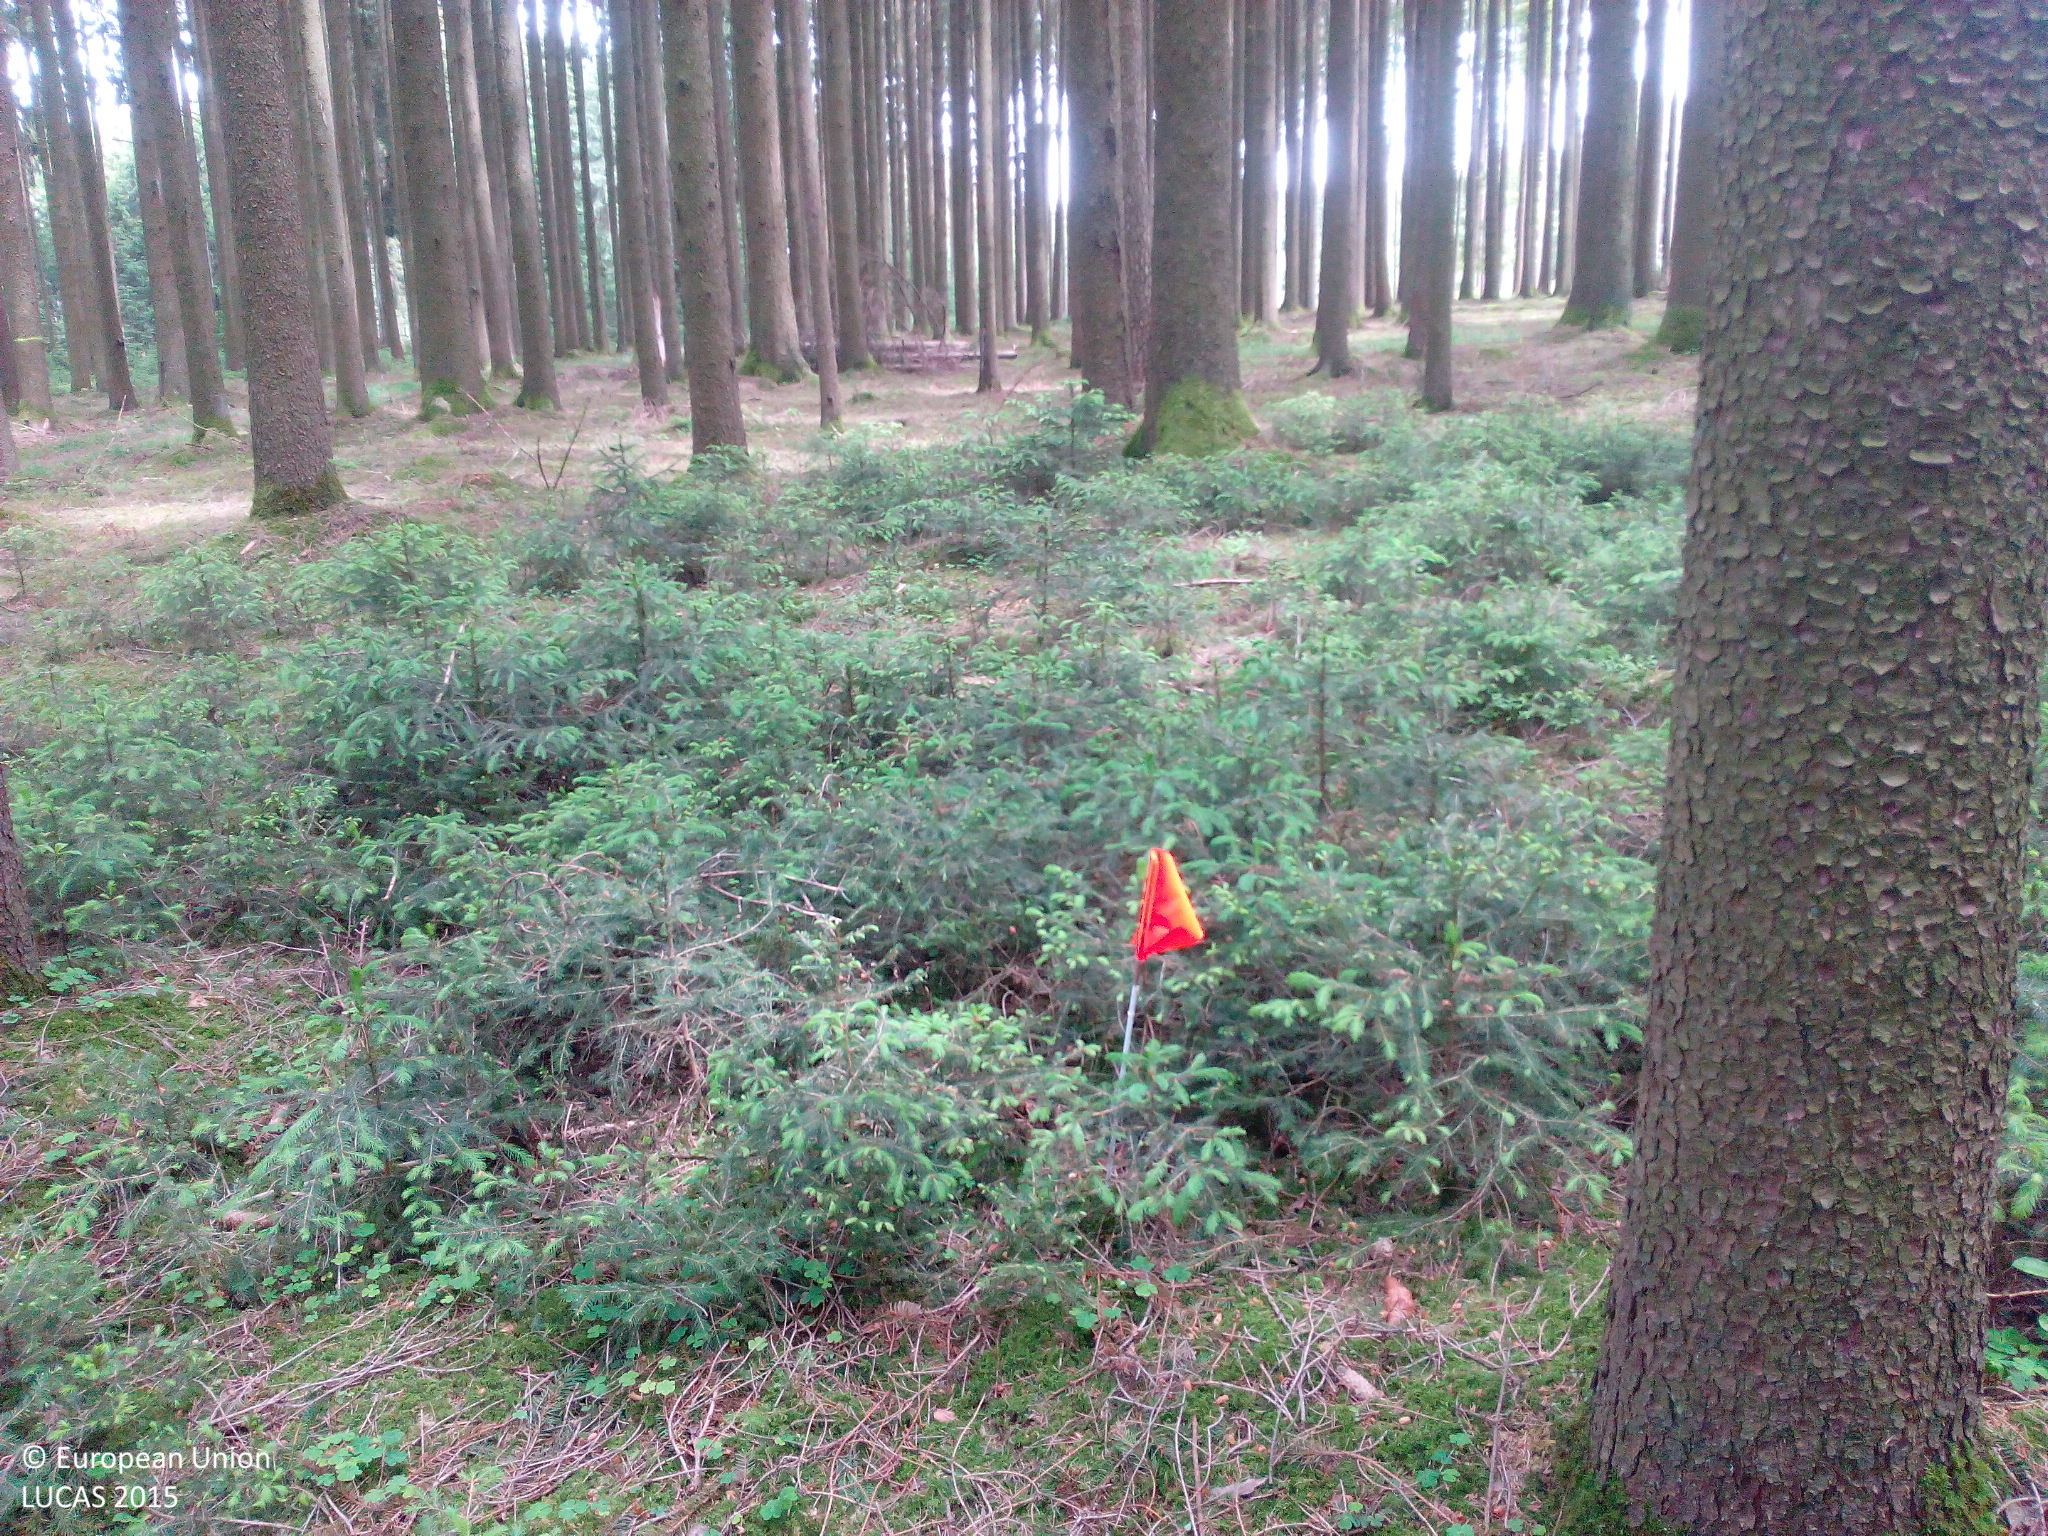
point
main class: Woodland
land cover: Spruce dominated coniferous woodland
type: hemiboreal forest and nemoral coniferous forest and mixed broadleaved-coniferous forest
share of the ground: > 75 %
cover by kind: coniferous forest trees 100 %
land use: Forestry
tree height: > 5 m
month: May
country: DE
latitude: 48.0613
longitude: 10.2548
